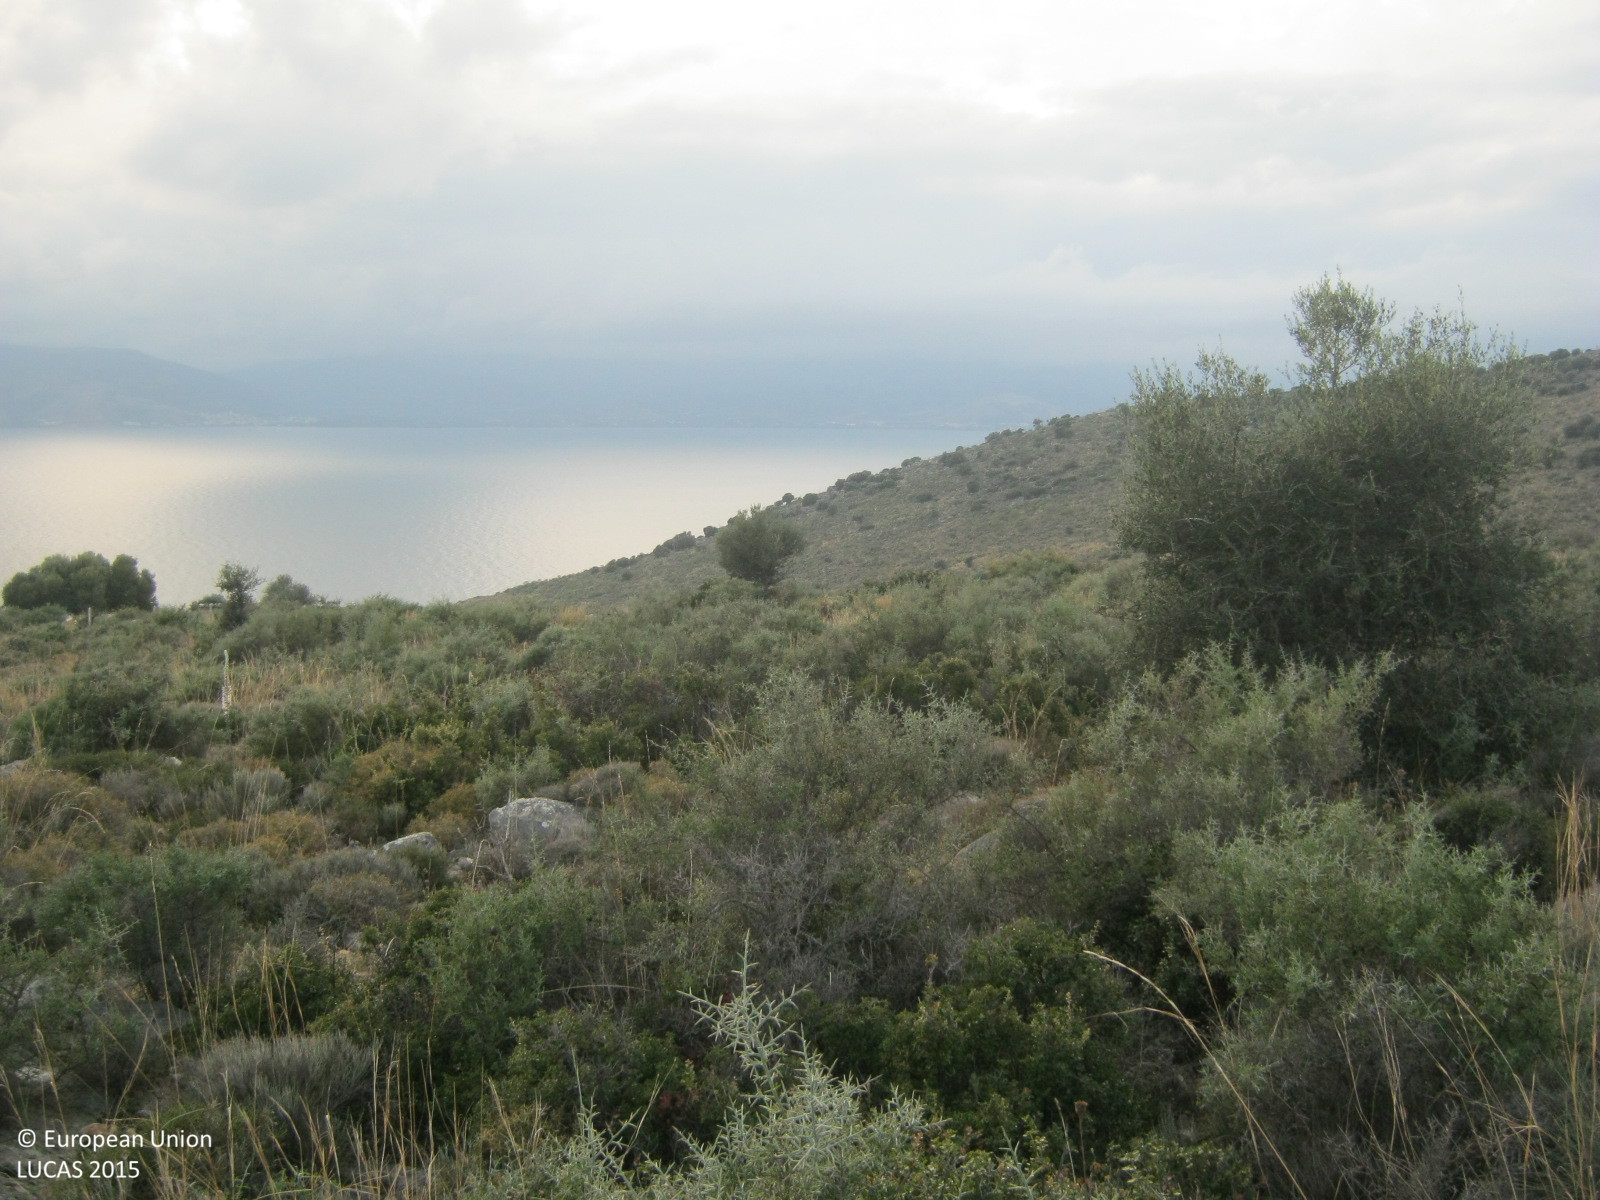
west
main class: Shrubland
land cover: Shrubland without tree cover
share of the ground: > 75 %
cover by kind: shrubs 80 %, herbaceous plants 10 %, unconsolidated bare surface 10 %
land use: Semi-natural and natural areas not in use
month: October
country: GR
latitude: 37.5553
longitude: 22.8137
